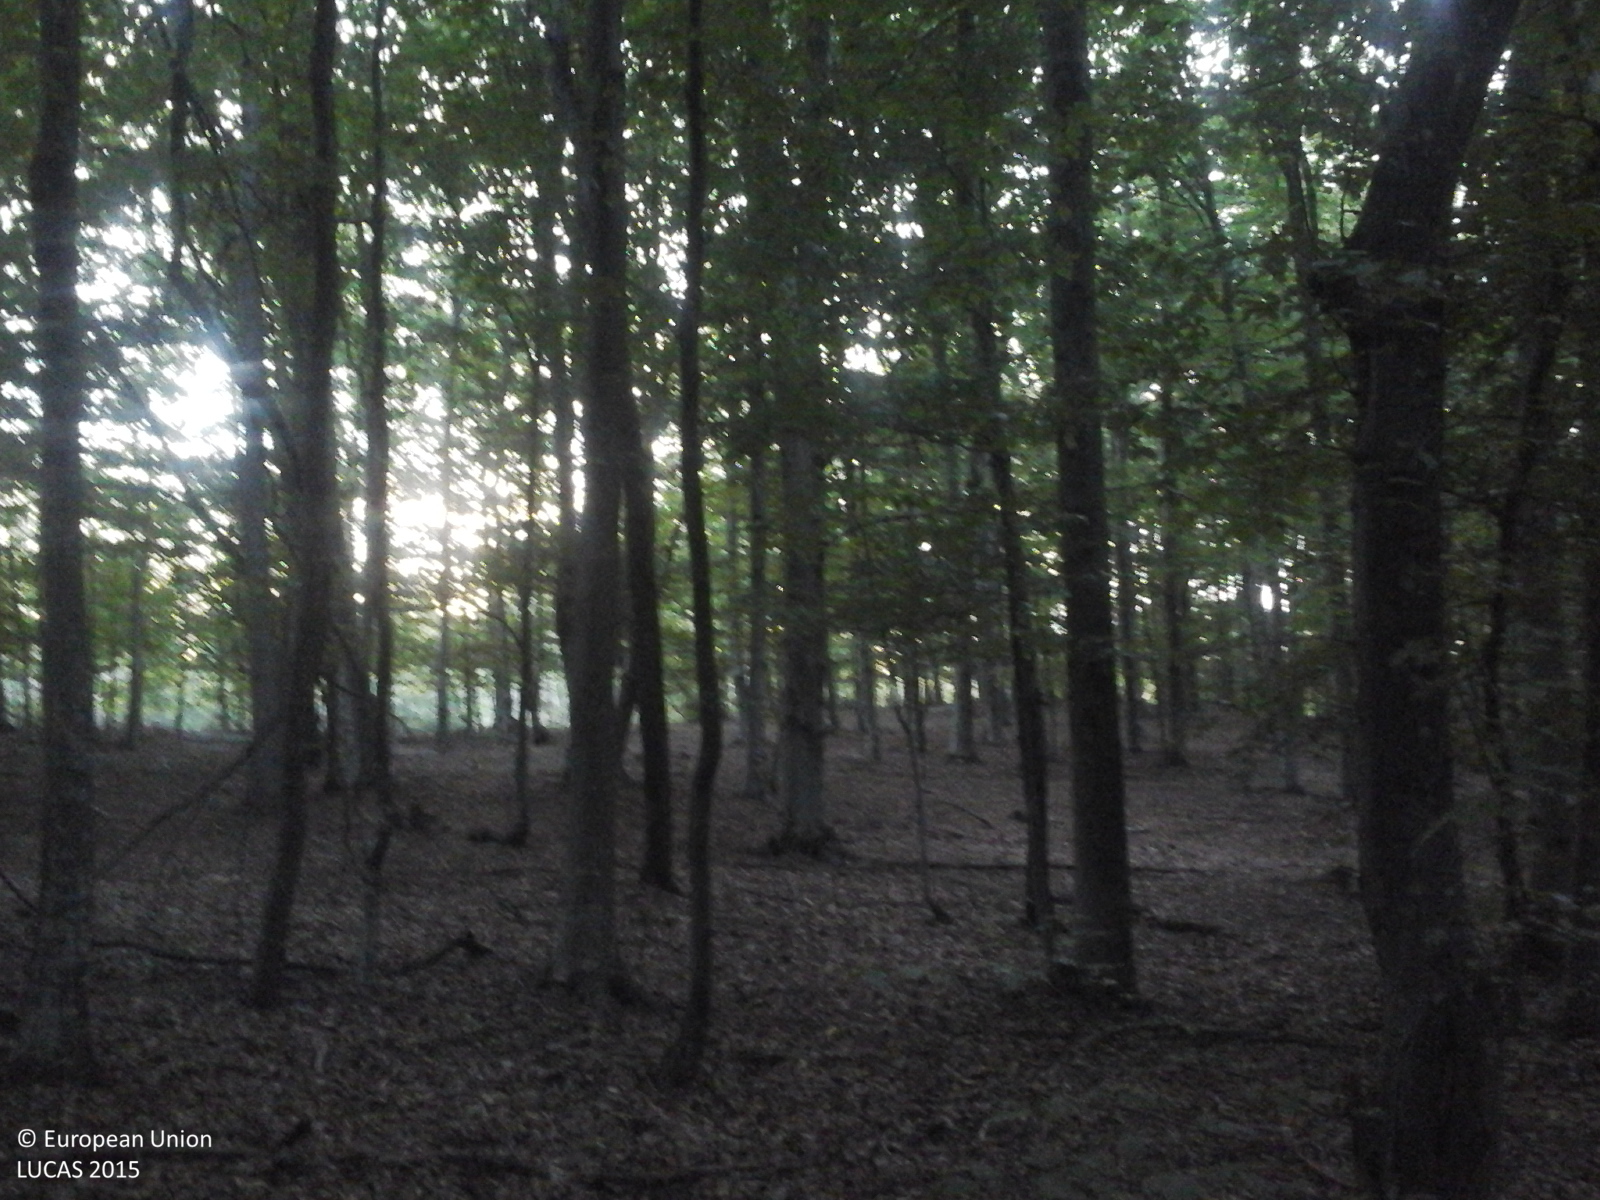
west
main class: Woodland
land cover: Broadleaved woodland
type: beech forest
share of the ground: > 75 %
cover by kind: broadleaved forest trees 100 %
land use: Forestry
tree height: > 5 m
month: September
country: RO
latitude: 47.1159
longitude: 22.5901
